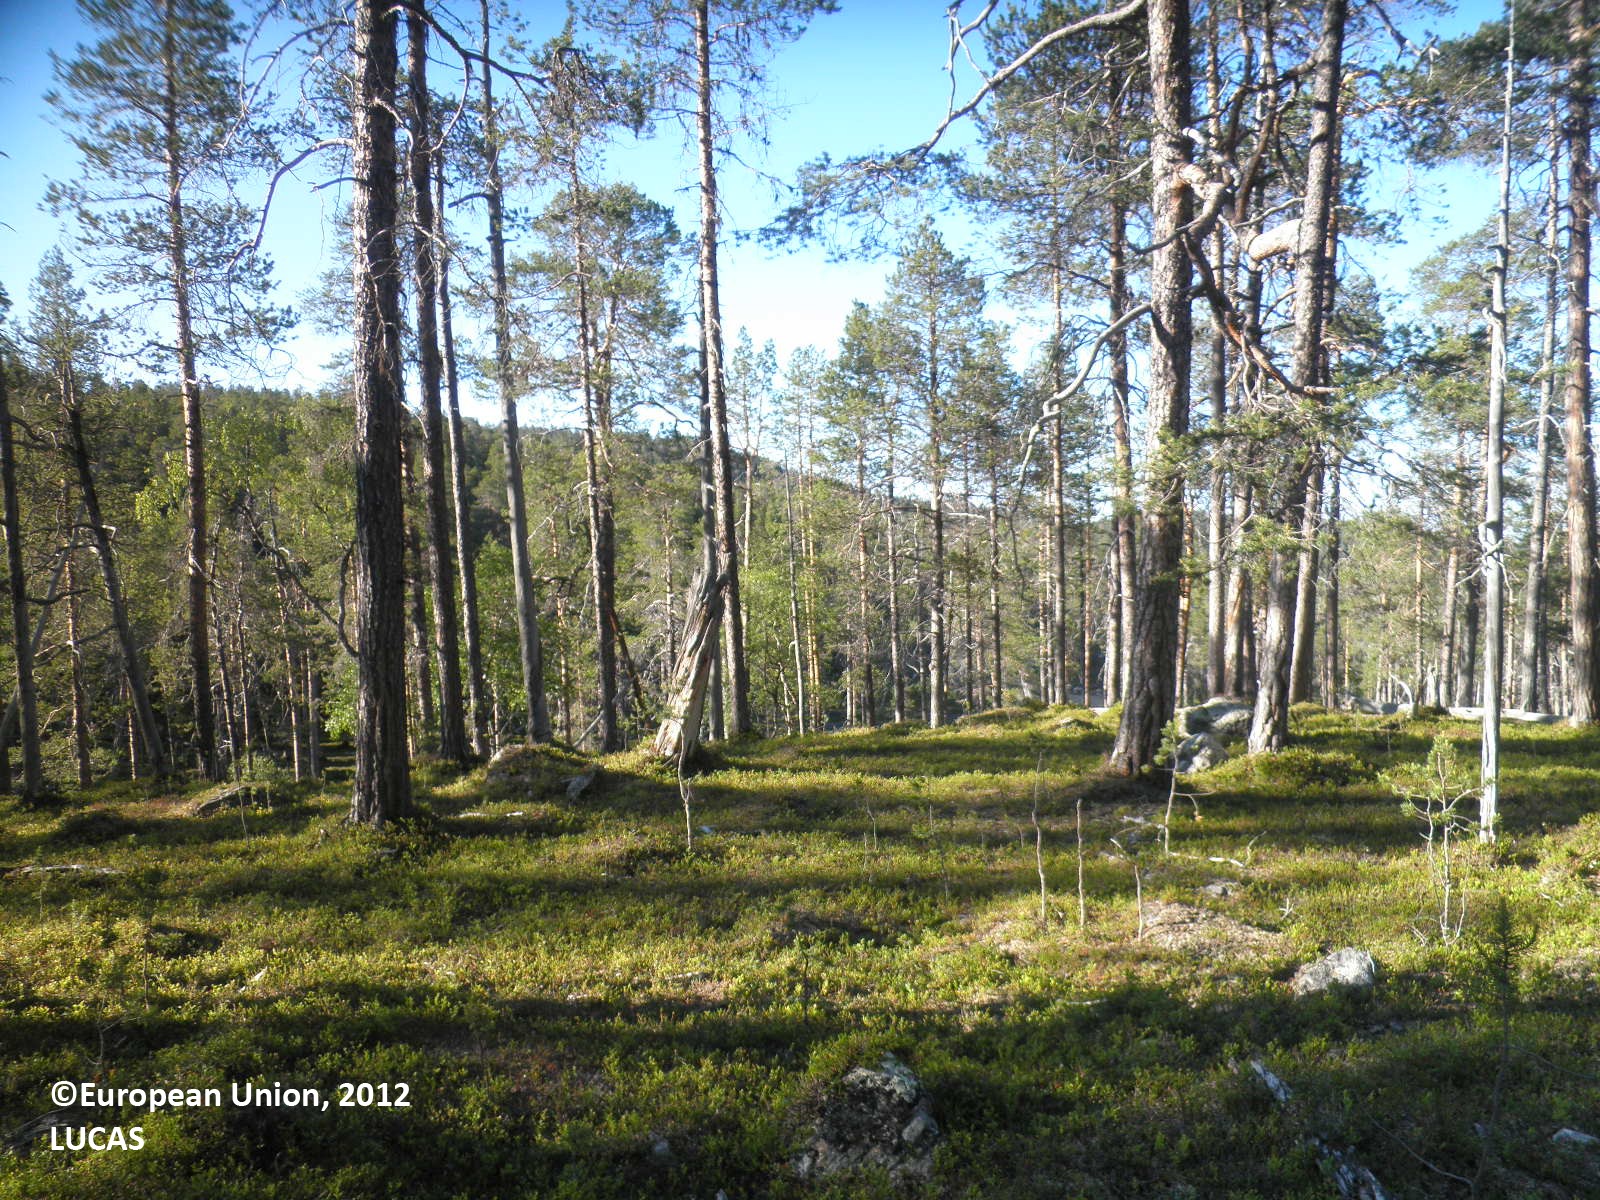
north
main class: Woodland
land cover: Pine dominated coniferous woodland
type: boreal forest
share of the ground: 50 - 75 %
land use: Forestry
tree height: > 5 m
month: July
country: FI
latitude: 68.7572
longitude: 27.2568
